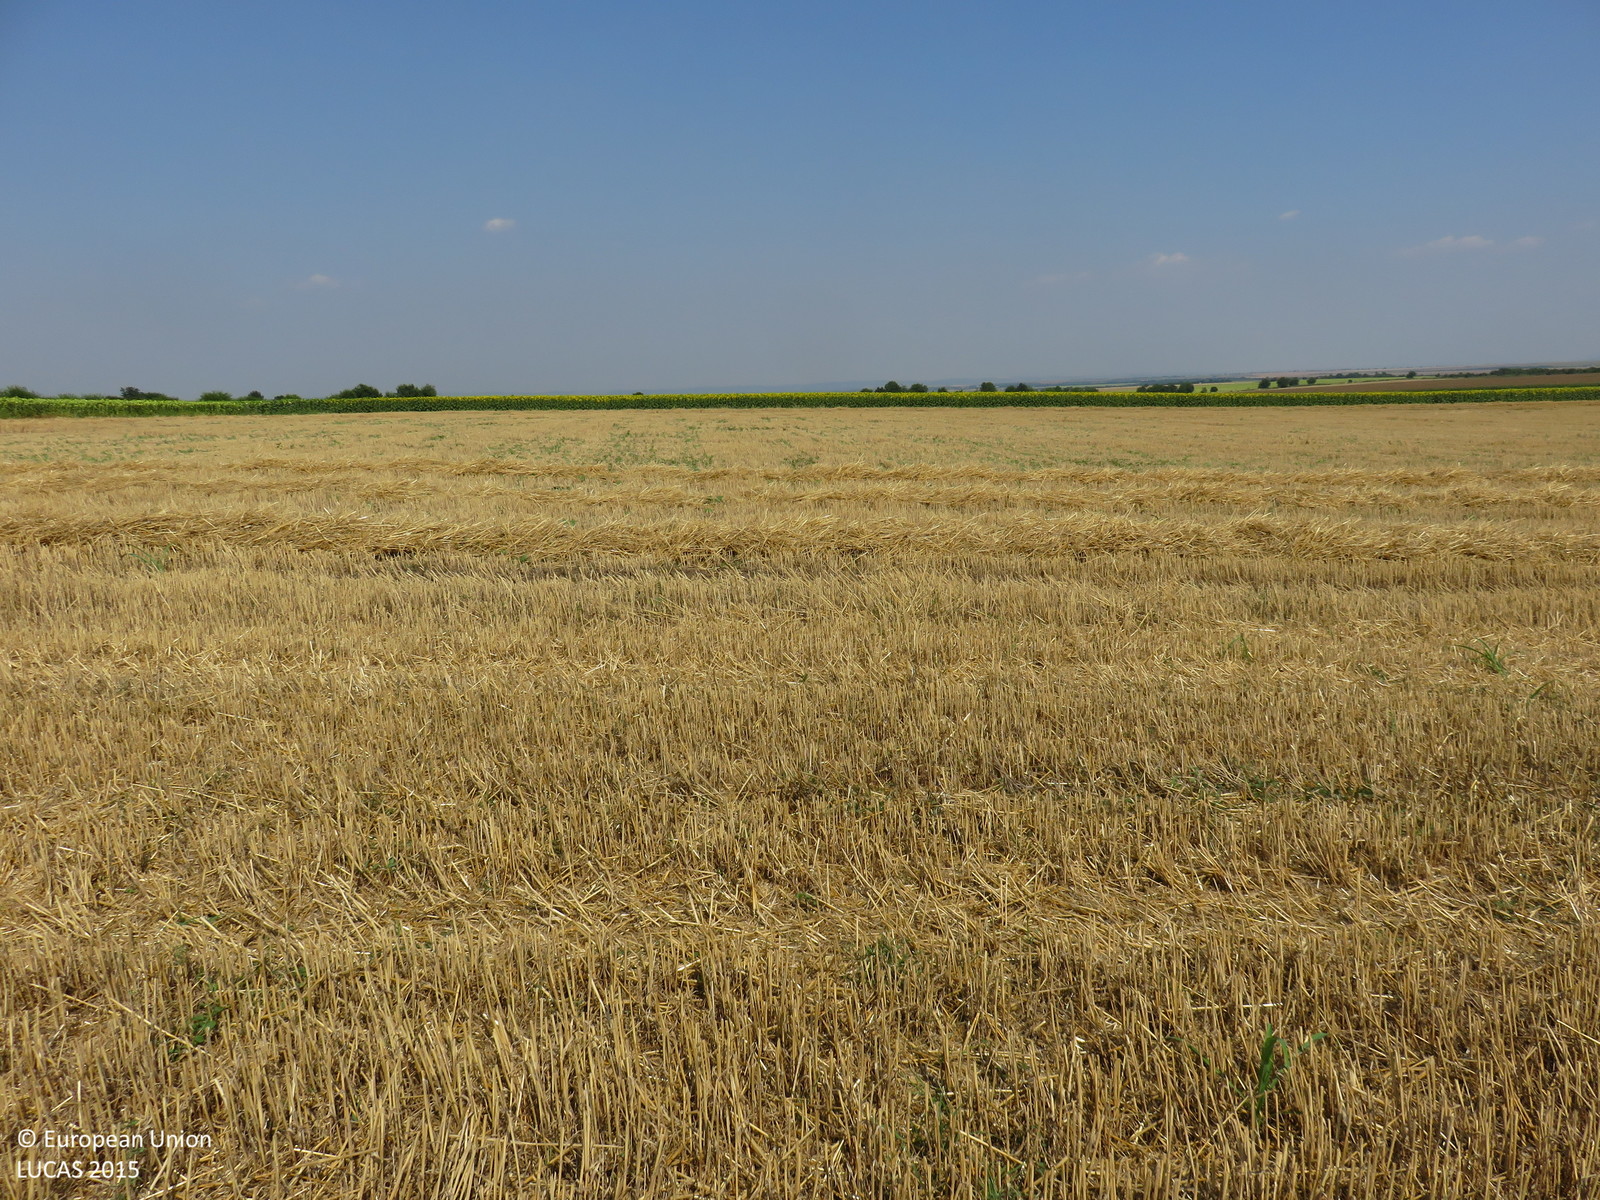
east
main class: Cropland
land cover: Common wheat
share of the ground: > 75 %
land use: Agriculture (excluding fallow land and kitchen gardens)
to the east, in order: Common wheat; Grass margins; Tracks; Grass margins; Sunflower; Grass margins; Sunflower
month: July
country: BG
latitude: 43.4530
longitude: 24.8856
